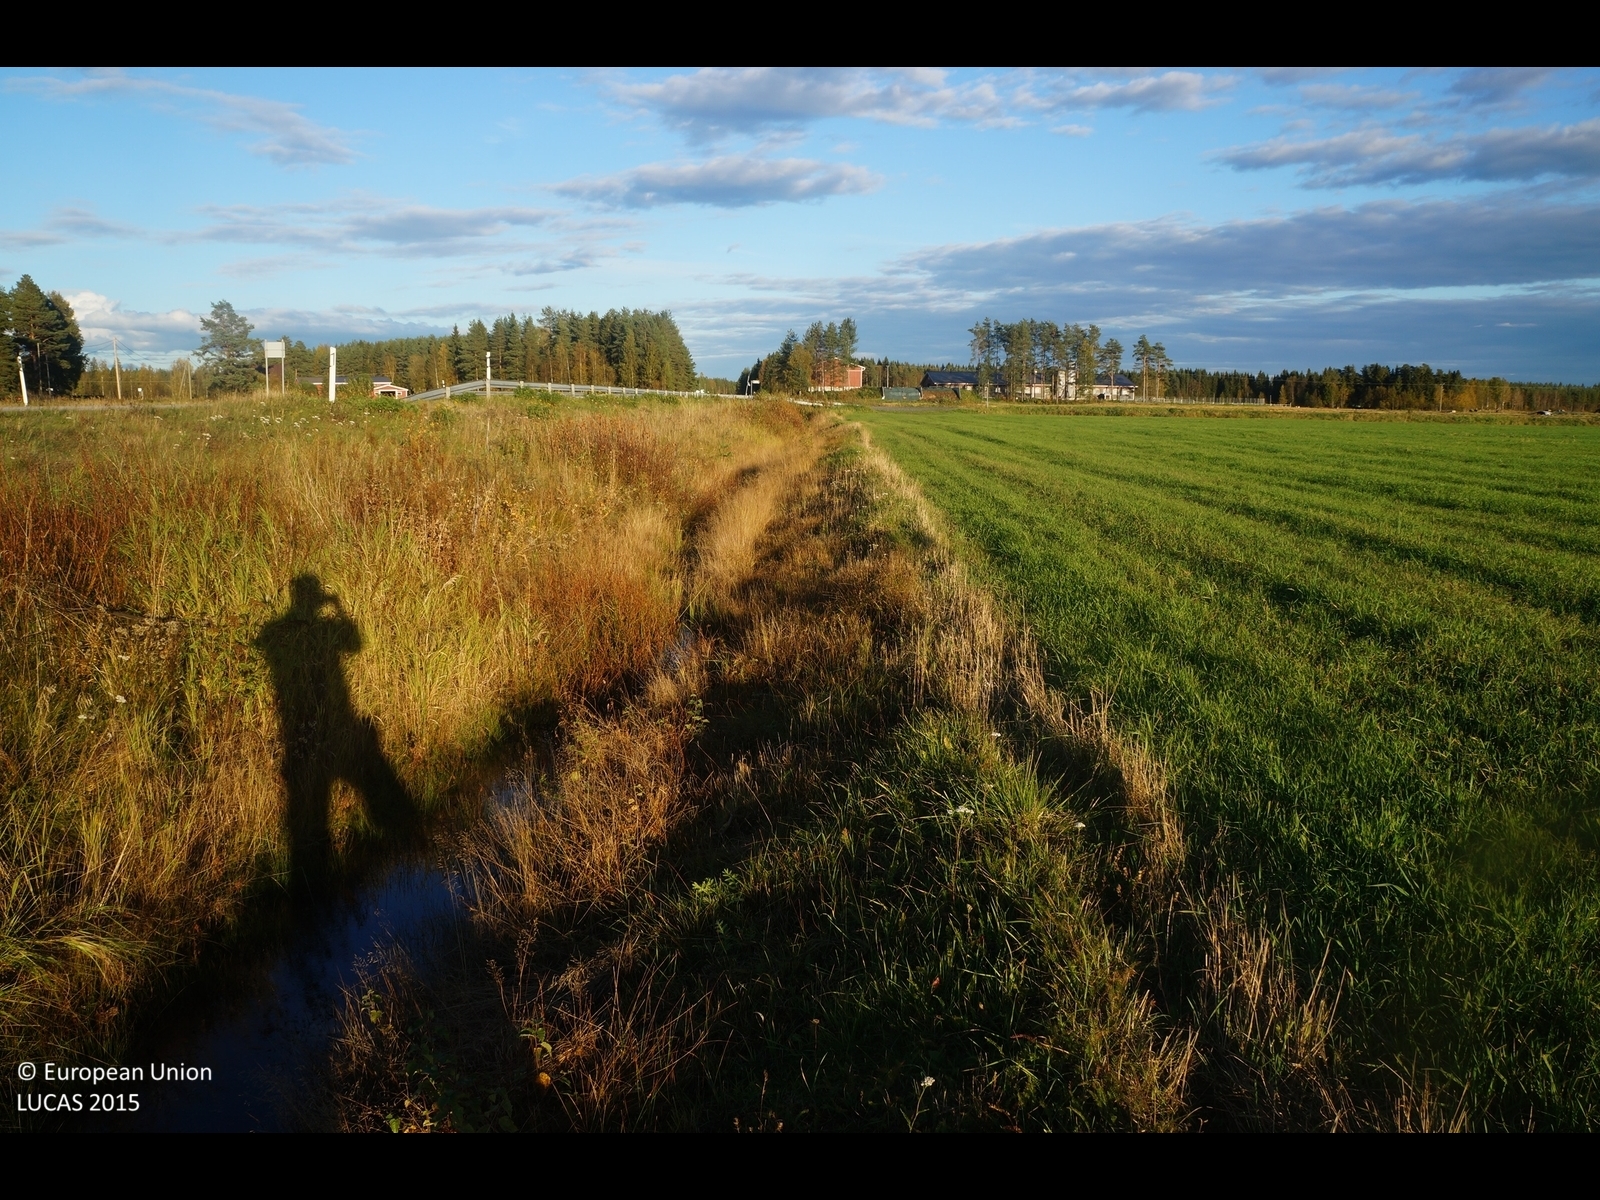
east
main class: Cropland
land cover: Temporary grasslands
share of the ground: > 75 %
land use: Agriculture (excluding fallow land and kitchen gardens)
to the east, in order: Temporary grasslands; Ditches and canals; Tracks; Shruby margins; Temporary grasslands; Electric lines; Ditches and canals; Temporary grasslands
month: September
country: FI
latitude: 64.1785
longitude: 24.2036
